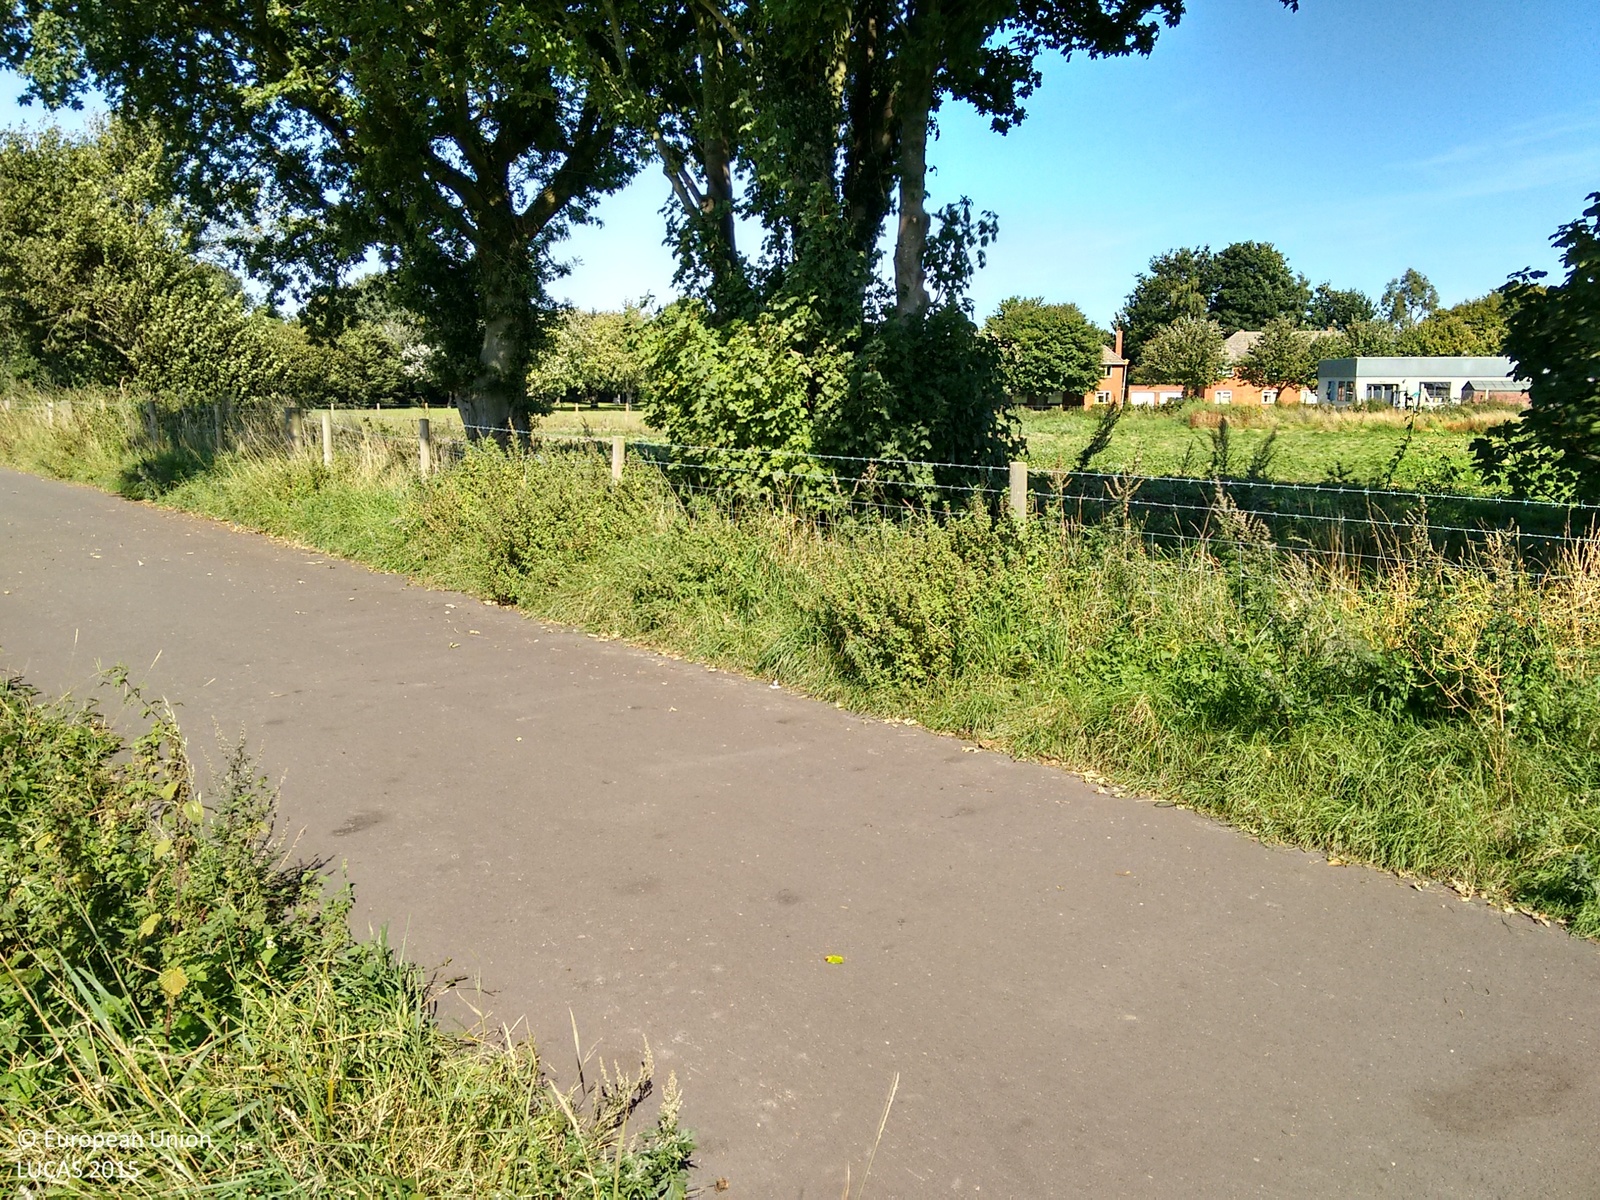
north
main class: Cropland
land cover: Common wheat
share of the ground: > 75 %
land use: Agriculture (excluding fallow land and kitchen gardens)
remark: Harvested field
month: September
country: GB
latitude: 52.5659
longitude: 0.8436
